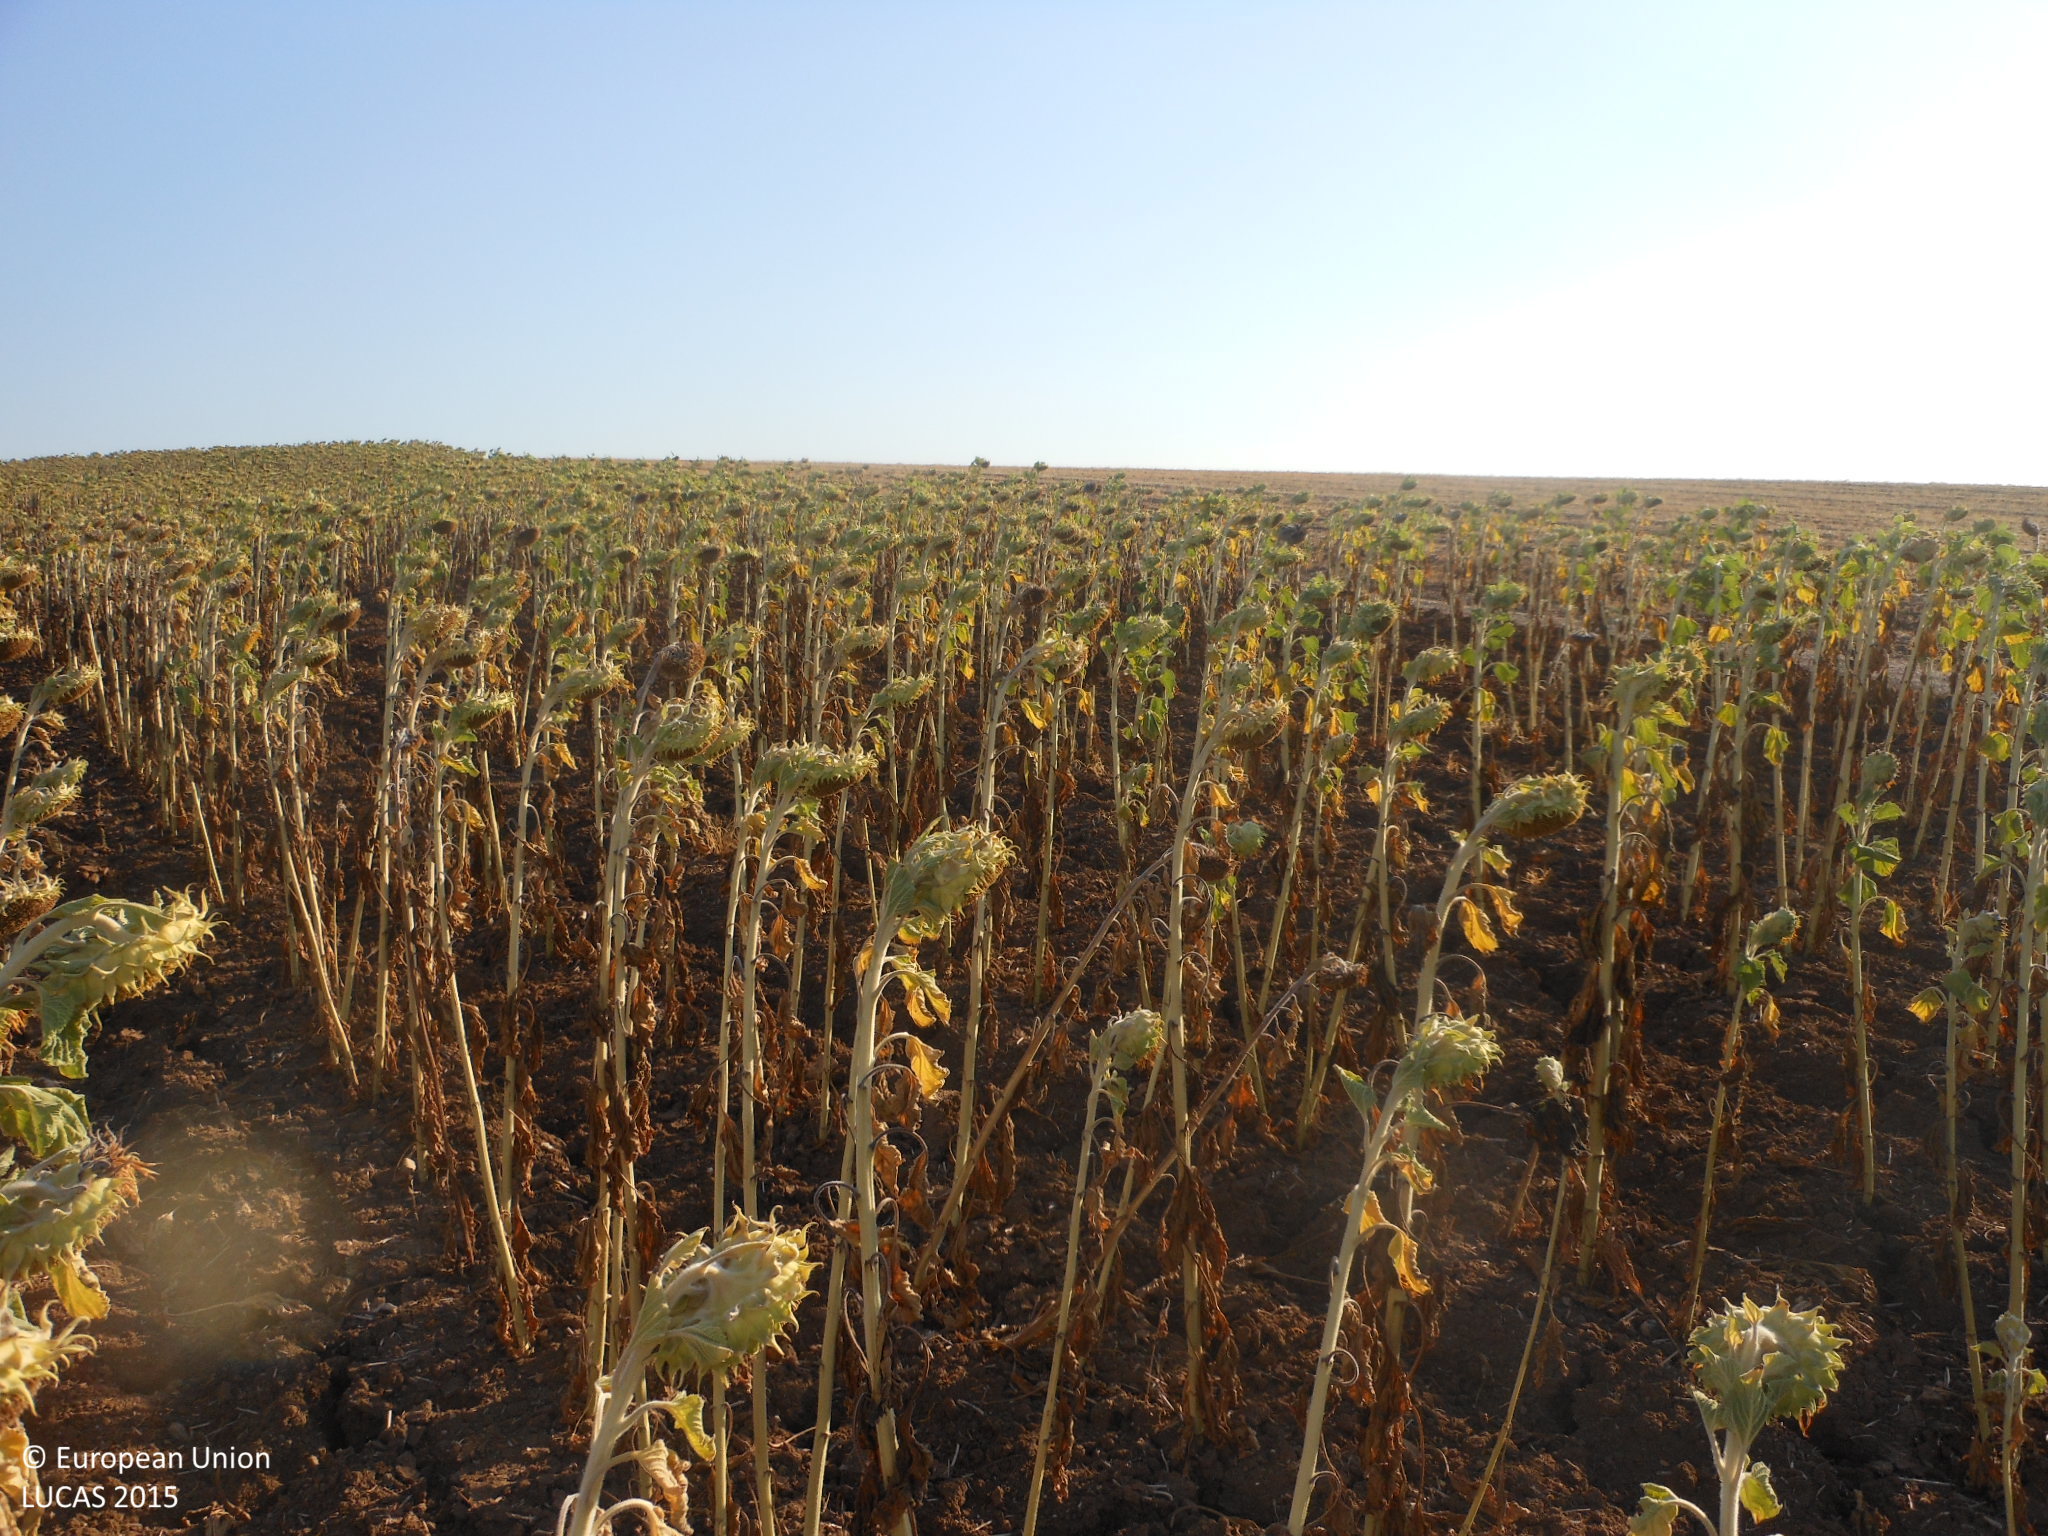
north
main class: Cropland
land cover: Sunflower
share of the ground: 50 - 75 %
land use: Agriculture (excluding fallow land and kitchen gardens)
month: June
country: ES
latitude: 37.5571
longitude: -4.9193
